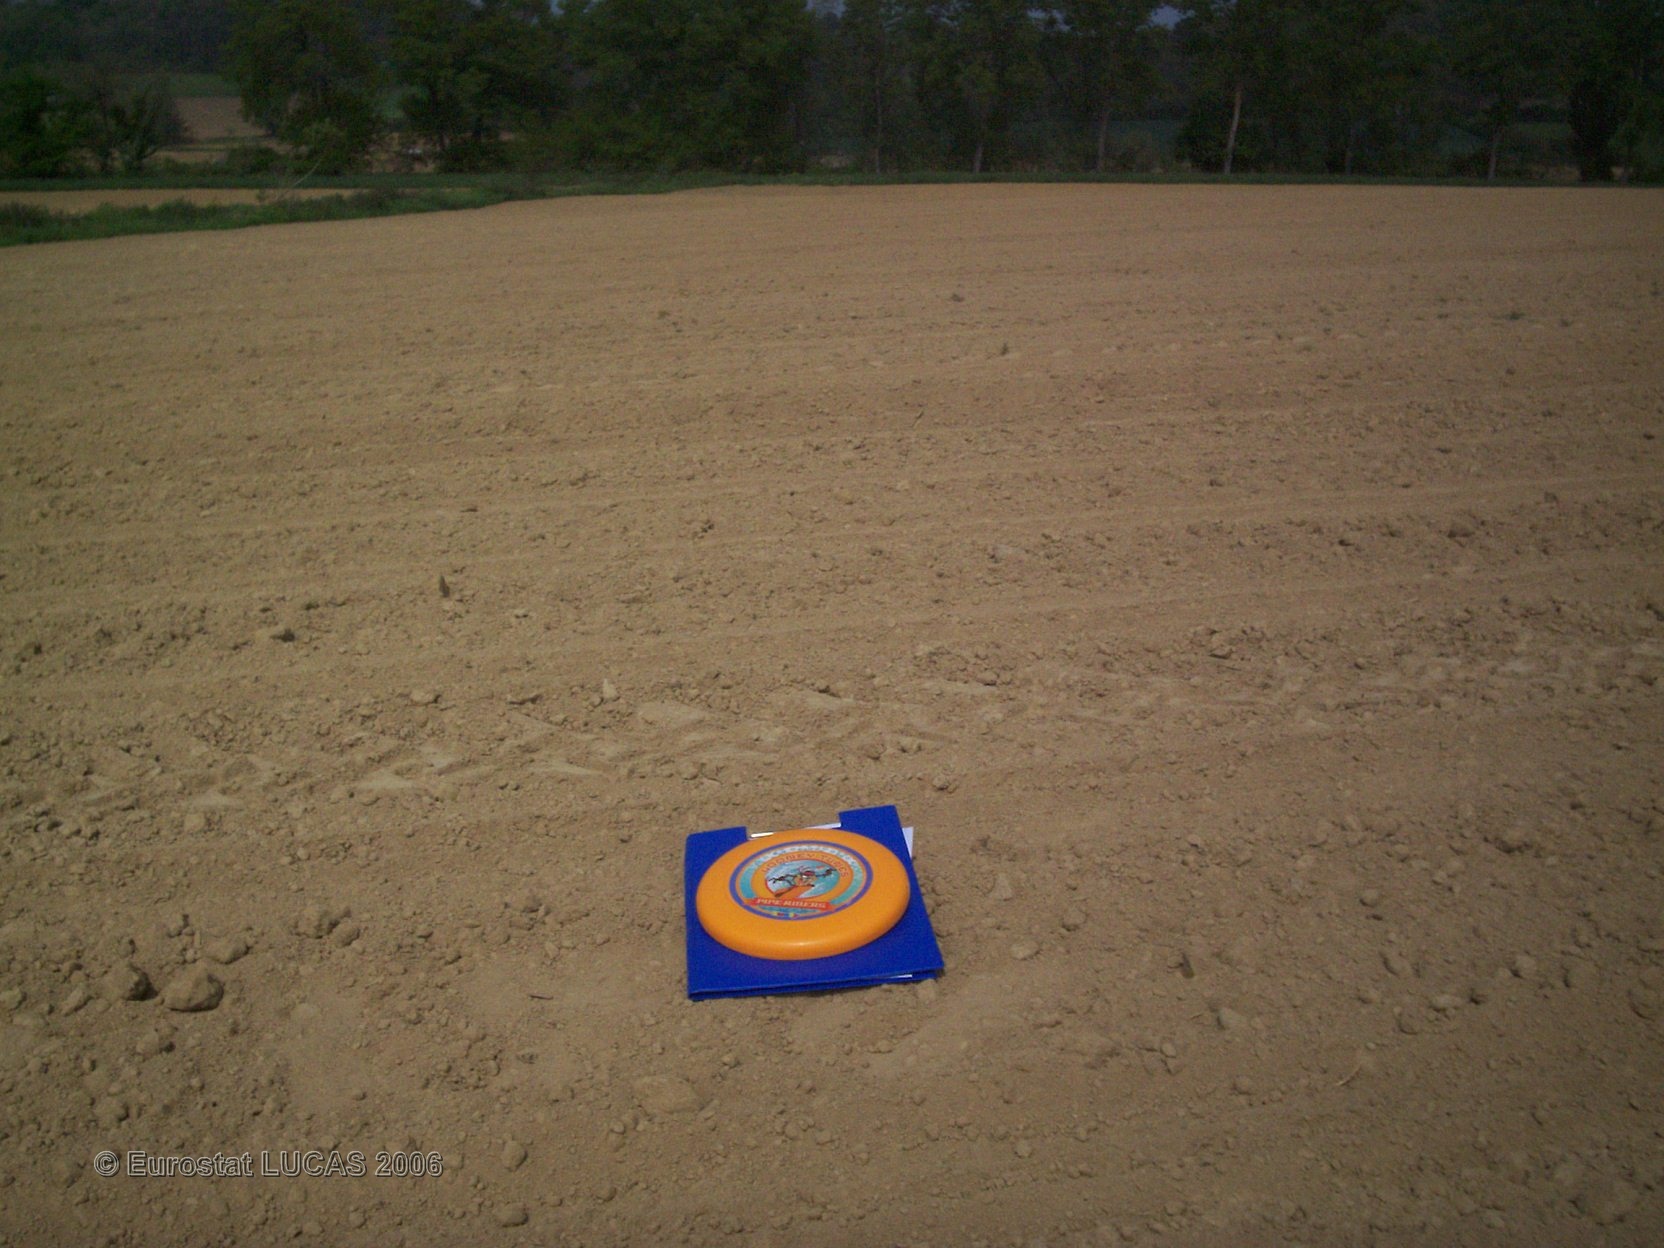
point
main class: Cropland
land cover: Maize
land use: Agriculture (excluding fallow land and kitchen gardens)
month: April
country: FR
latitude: 43.6591
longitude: -0.4383
